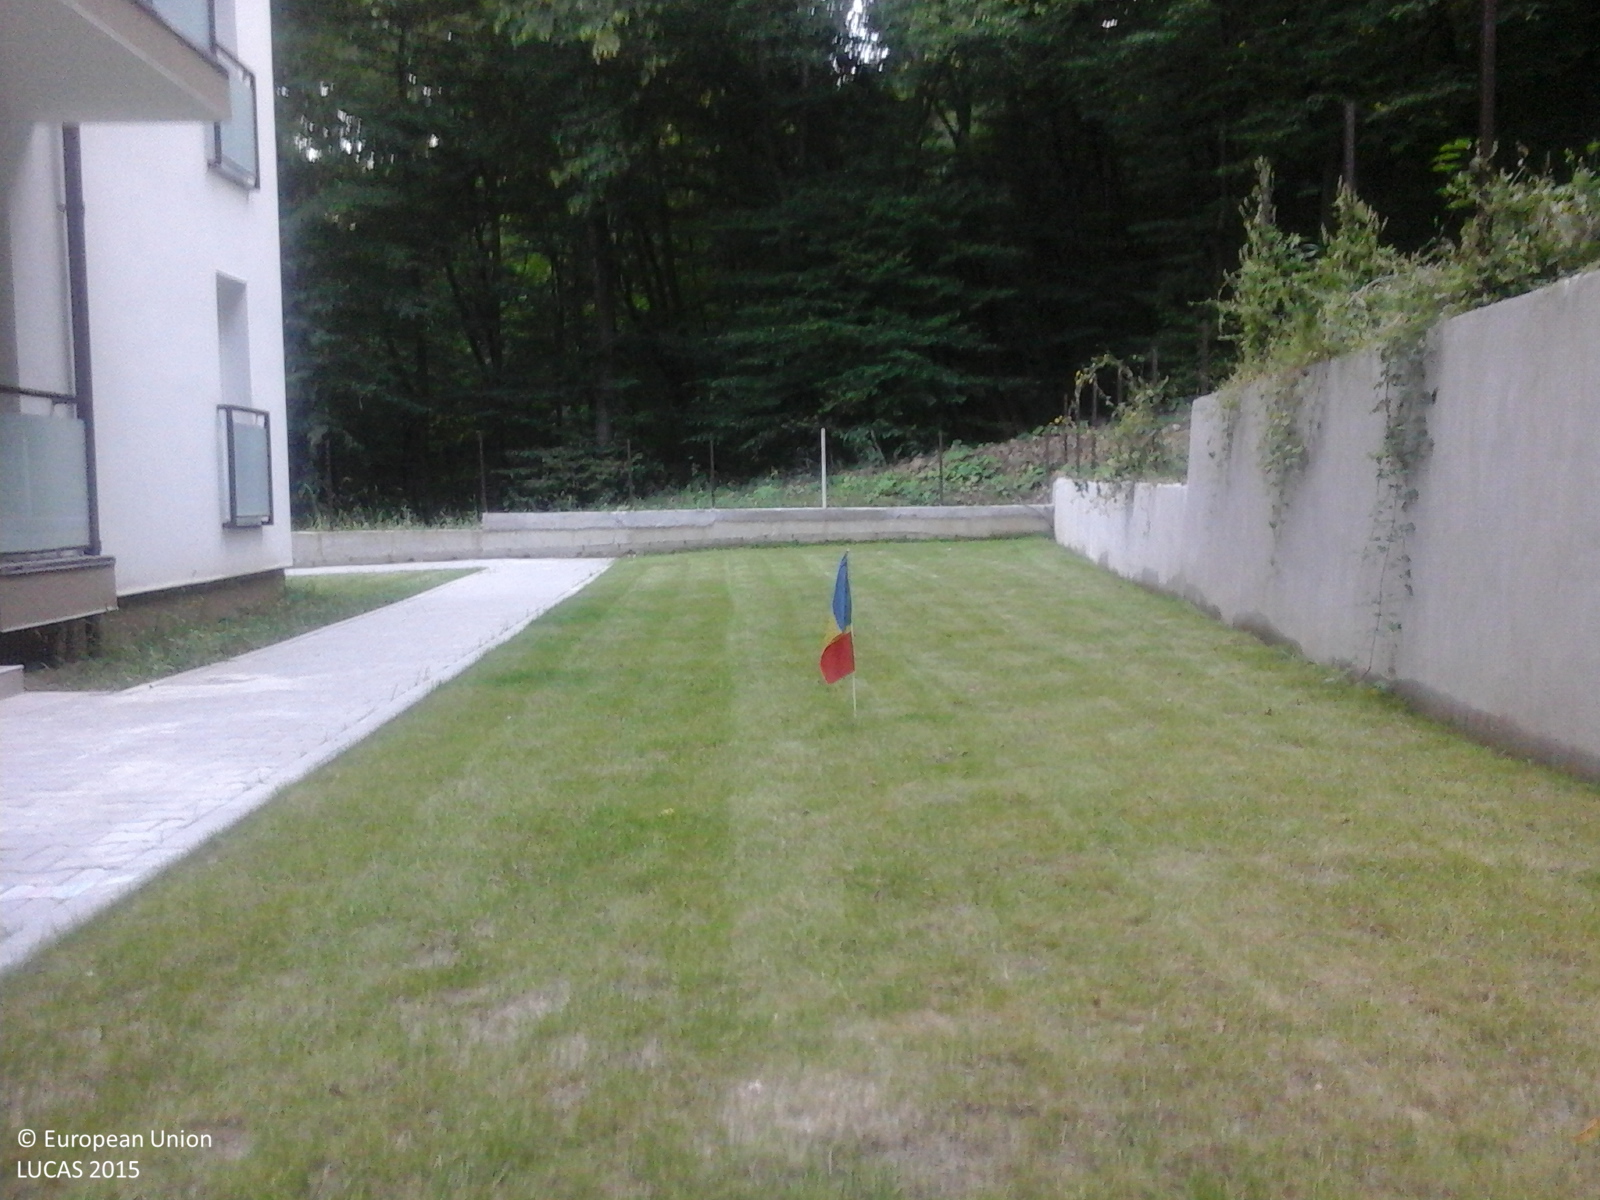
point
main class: Grassland
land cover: Grassland without tree/shrub cover
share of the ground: > 75 %
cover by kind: herbaceous plants 100 %
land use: Agriculture (excluding fallow land and kitchen gardens)
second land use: Residential
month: September
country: RO
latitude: 46.7417
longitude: 23.5644
